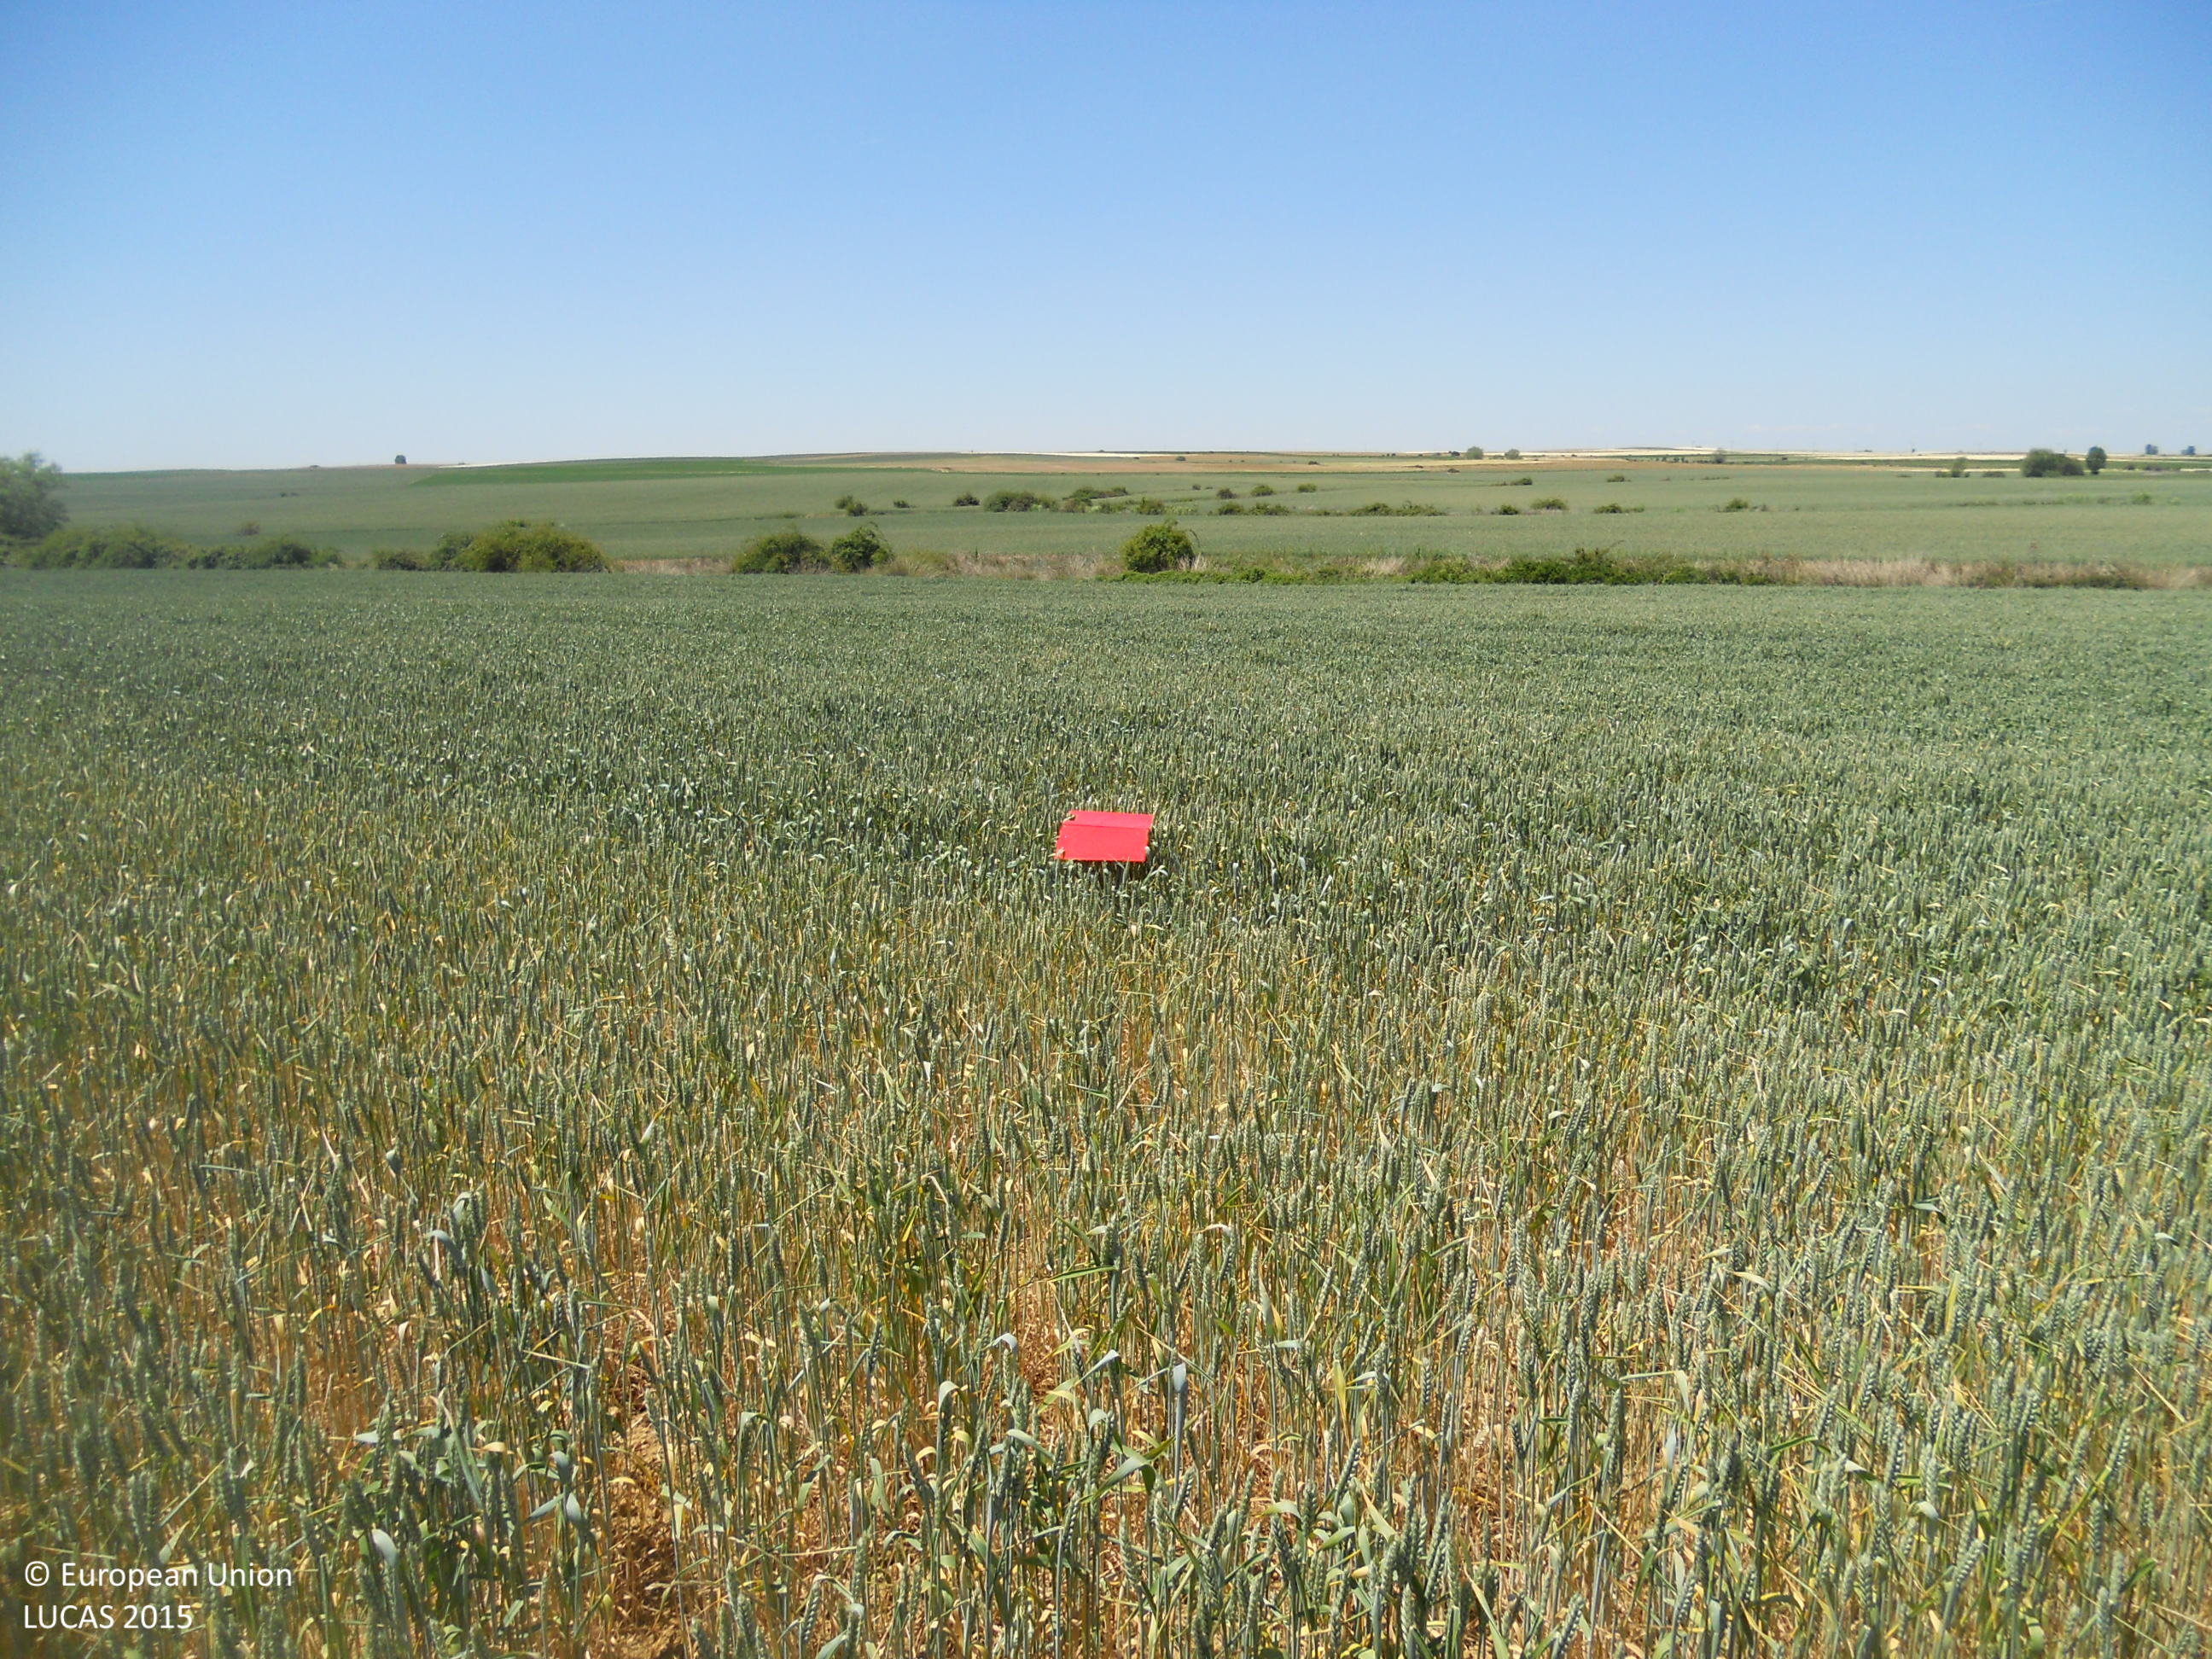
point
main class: Cropland
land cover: Common wheat
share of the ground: > 75 %
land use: Agriculture (excluding fallow land and kitchen gardens)
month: May
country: ES
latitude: 42.2803
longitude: -4.7623
